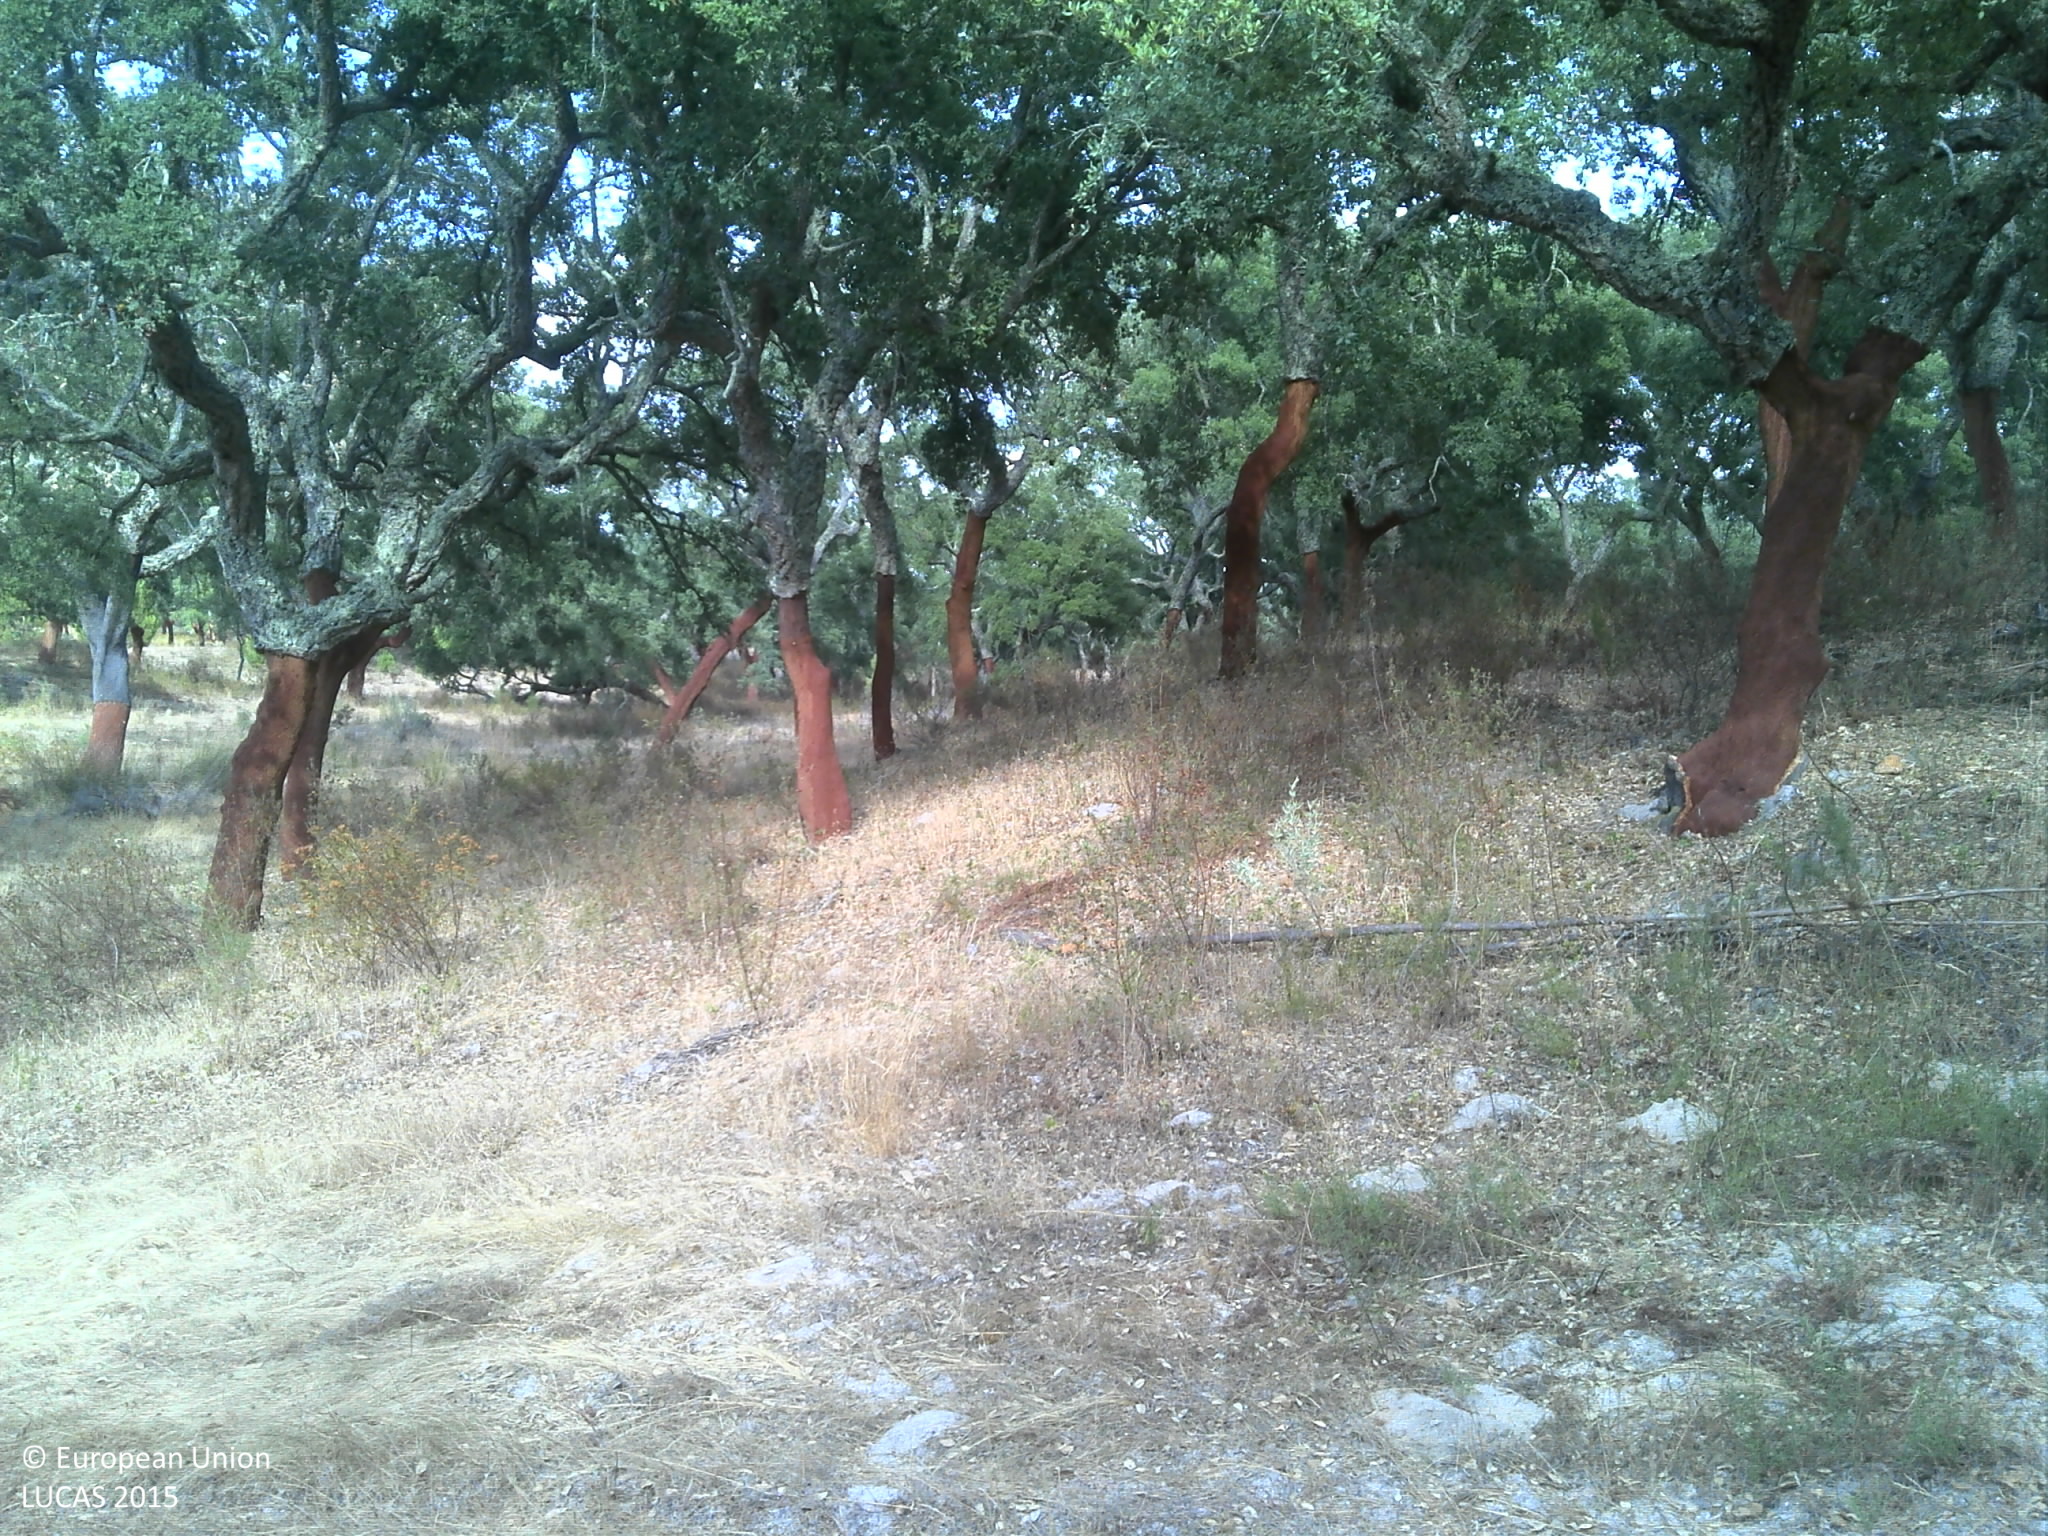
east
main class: Woodland
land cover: Broadleaved woodland
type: broadleaved evergreen forest
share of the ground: 50 - 75 %
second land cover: Grassland without tree/shrub cover
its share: 25 - 50 %
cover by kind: broadleaved forest trees 50 %, herbaceous plants 25 %, unconsolidated bare surface 25 %
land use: Forestry
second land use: Agriculture (excluding fallow land and kitchen gardens)
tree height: > 5 m
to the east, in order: Broadleaved woodland; Grassland without tree/shrub cover; Broadleaved woodland; Rivers and streams; Broadleaved woodland; Rivers and streams; Broadleaved woodland
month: July
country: PT
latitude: 38.9019
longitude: -8.1908
